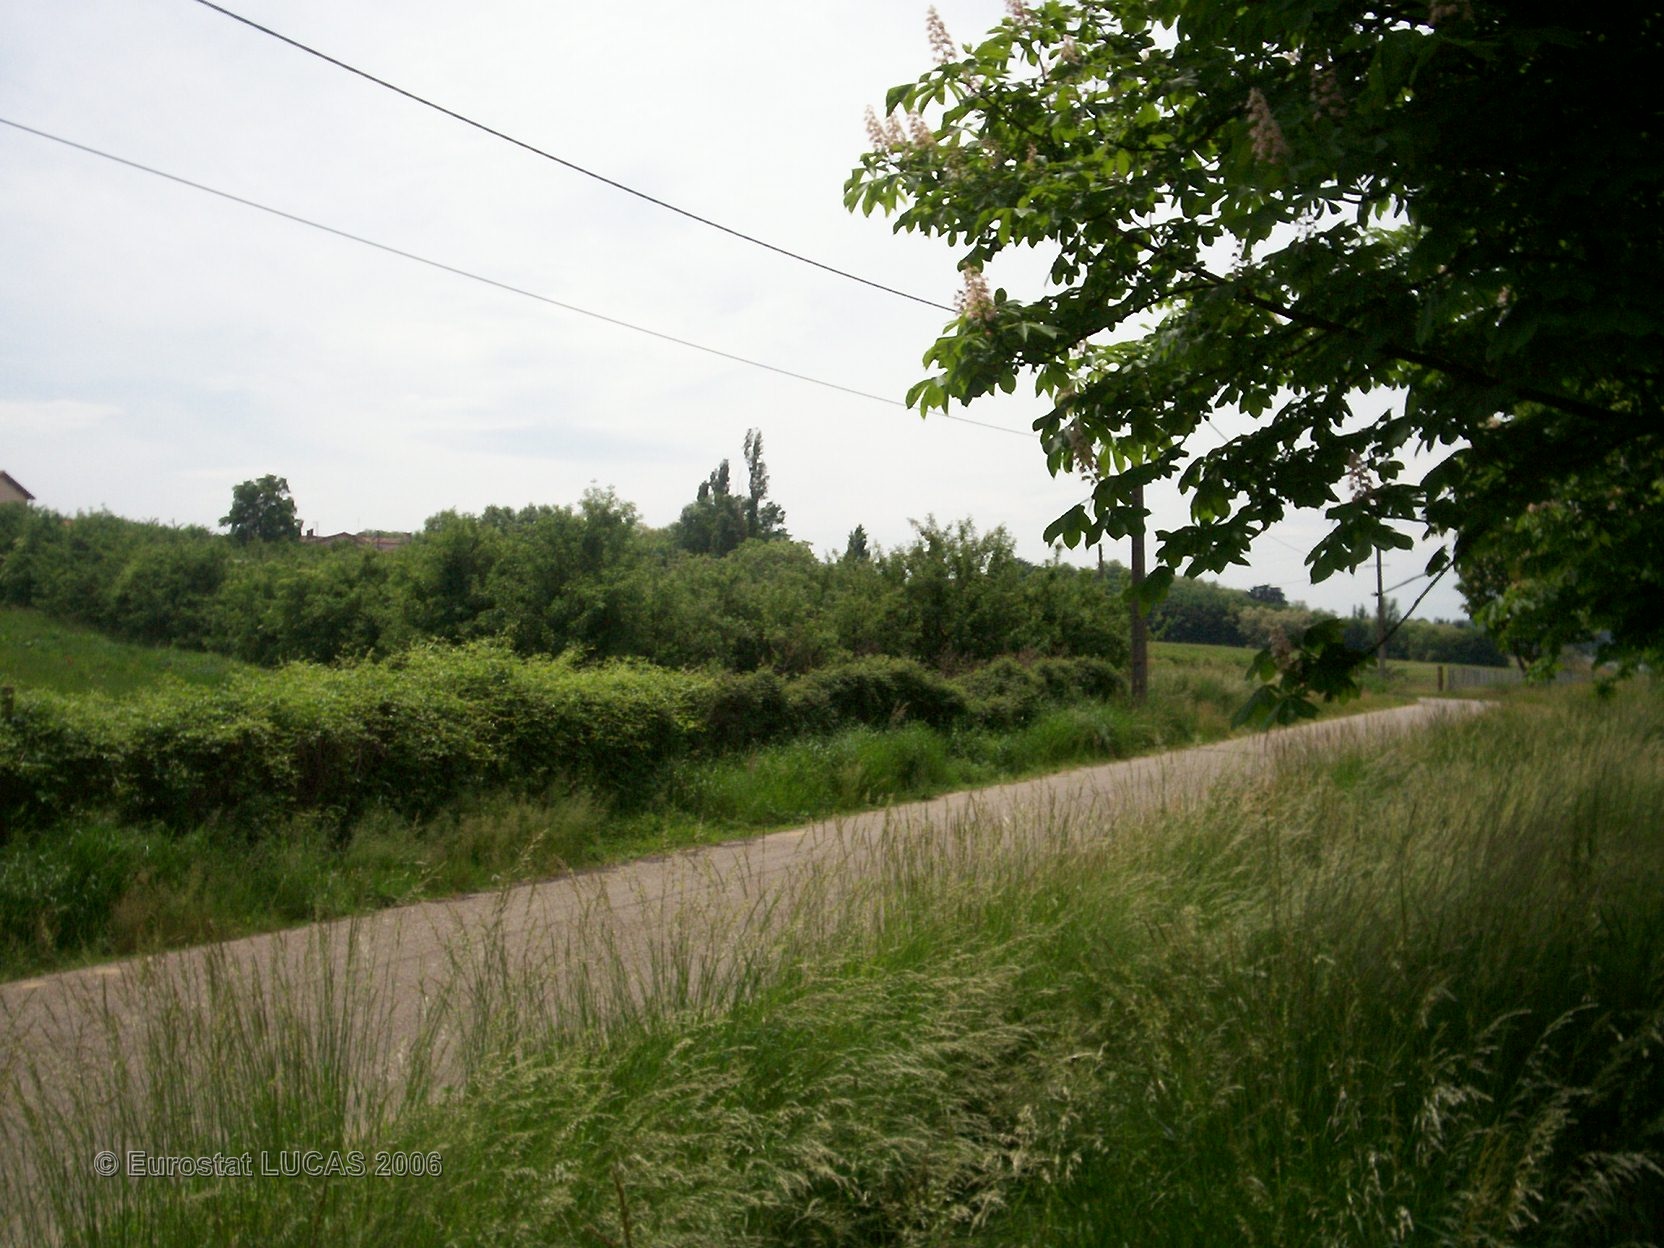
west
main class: Grassland
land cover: Grassland with sparse tree/shrub cover
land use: Unused
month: May
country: FR
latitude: 45.6834
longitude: 4.8038
